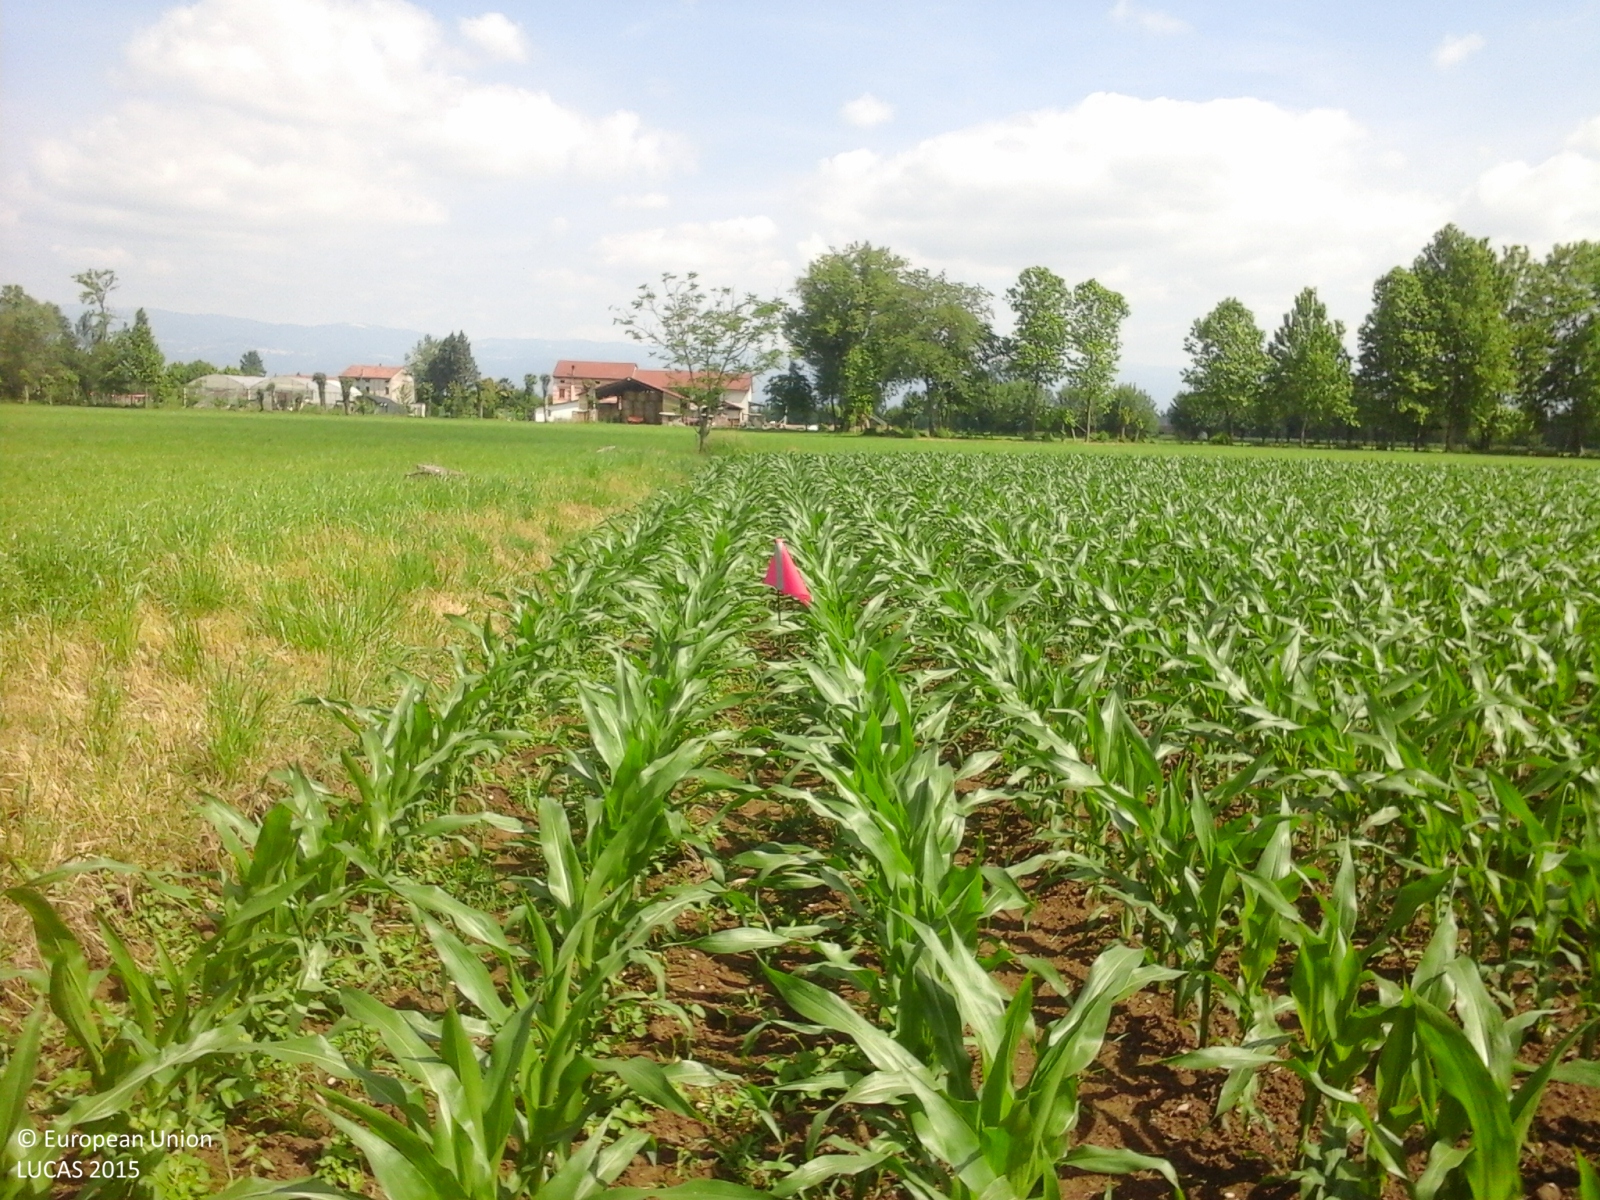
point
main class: Cropland
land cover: Maize
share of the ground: 50 - 75 %
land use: Agriculture (excluding fallow land and kitchen gardens)
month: May
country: IT
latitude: 45.6181
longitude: 11.6261
